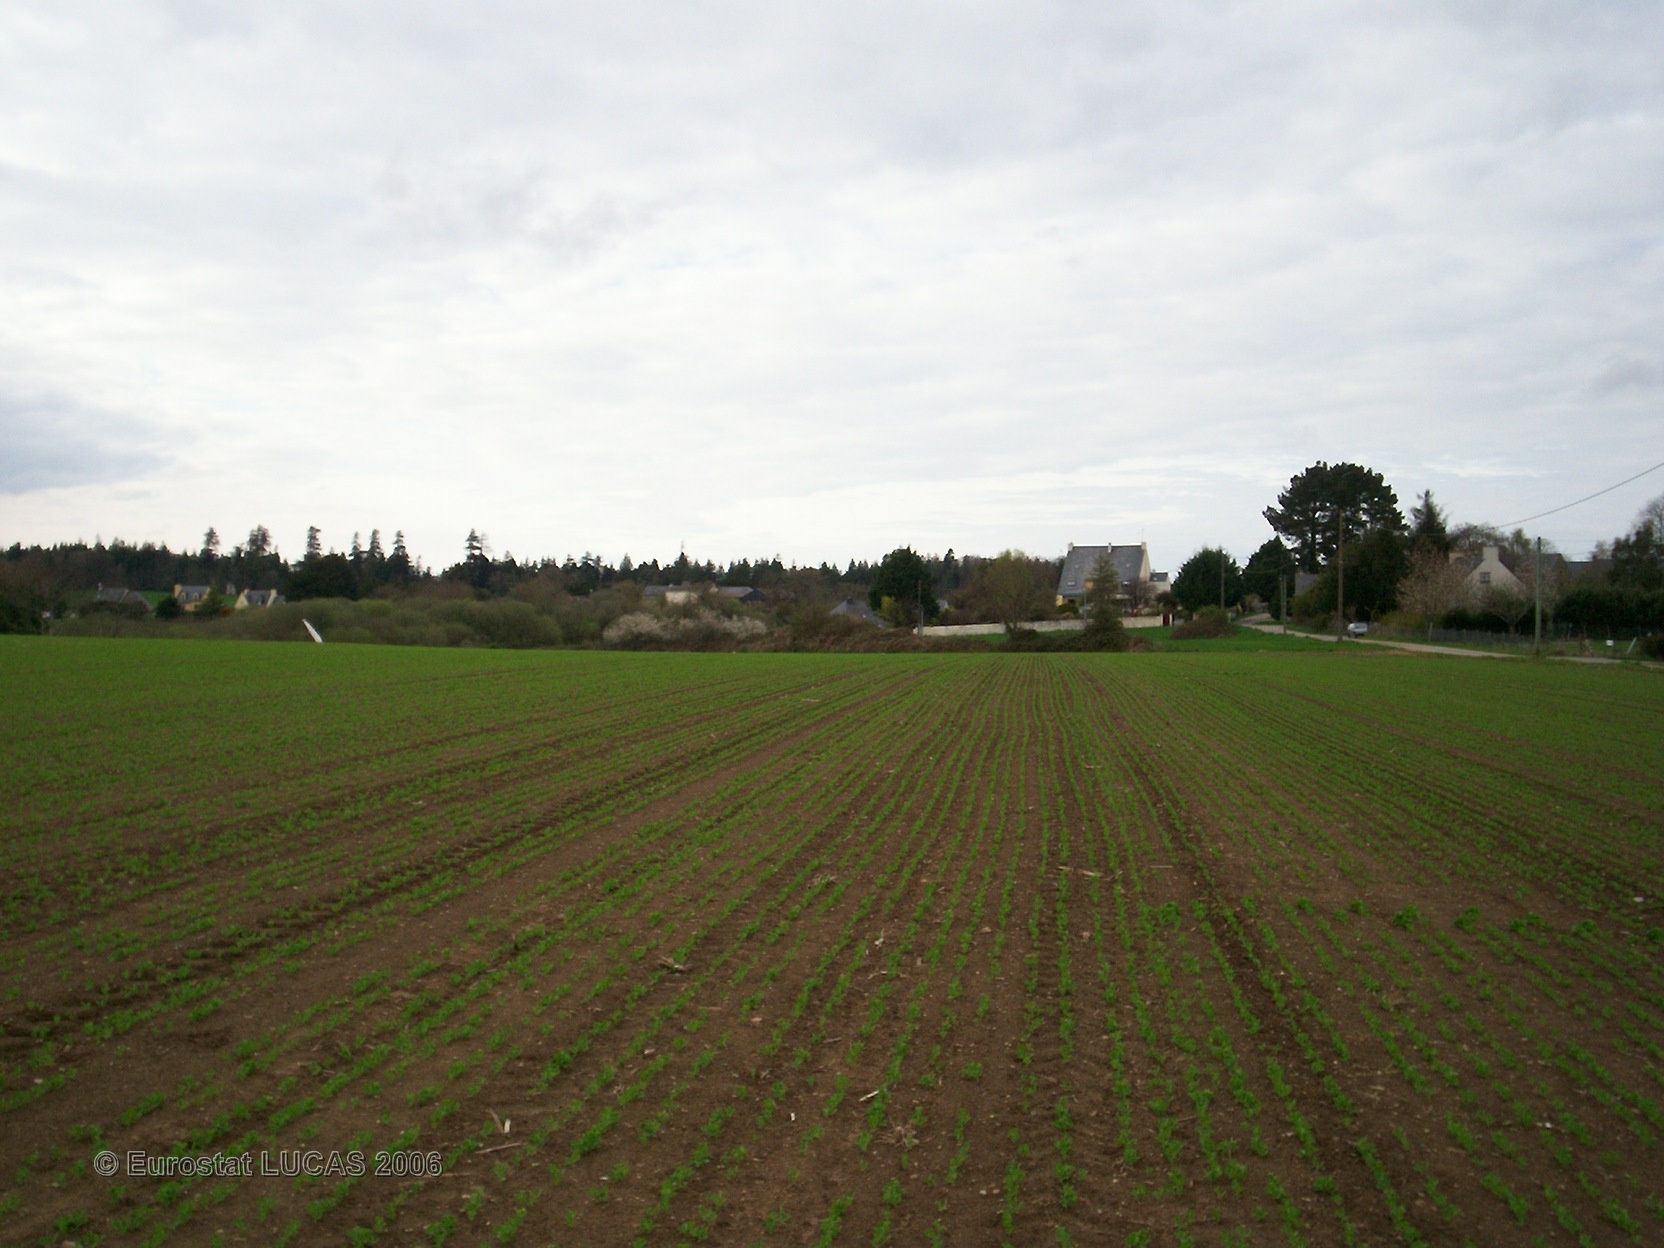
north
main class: Cropland
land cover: Dry pulses
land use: Agriculture (excluding fallow land and kitchen gardens)
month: April
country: FR
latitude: 47.8229
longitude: -3.5267
